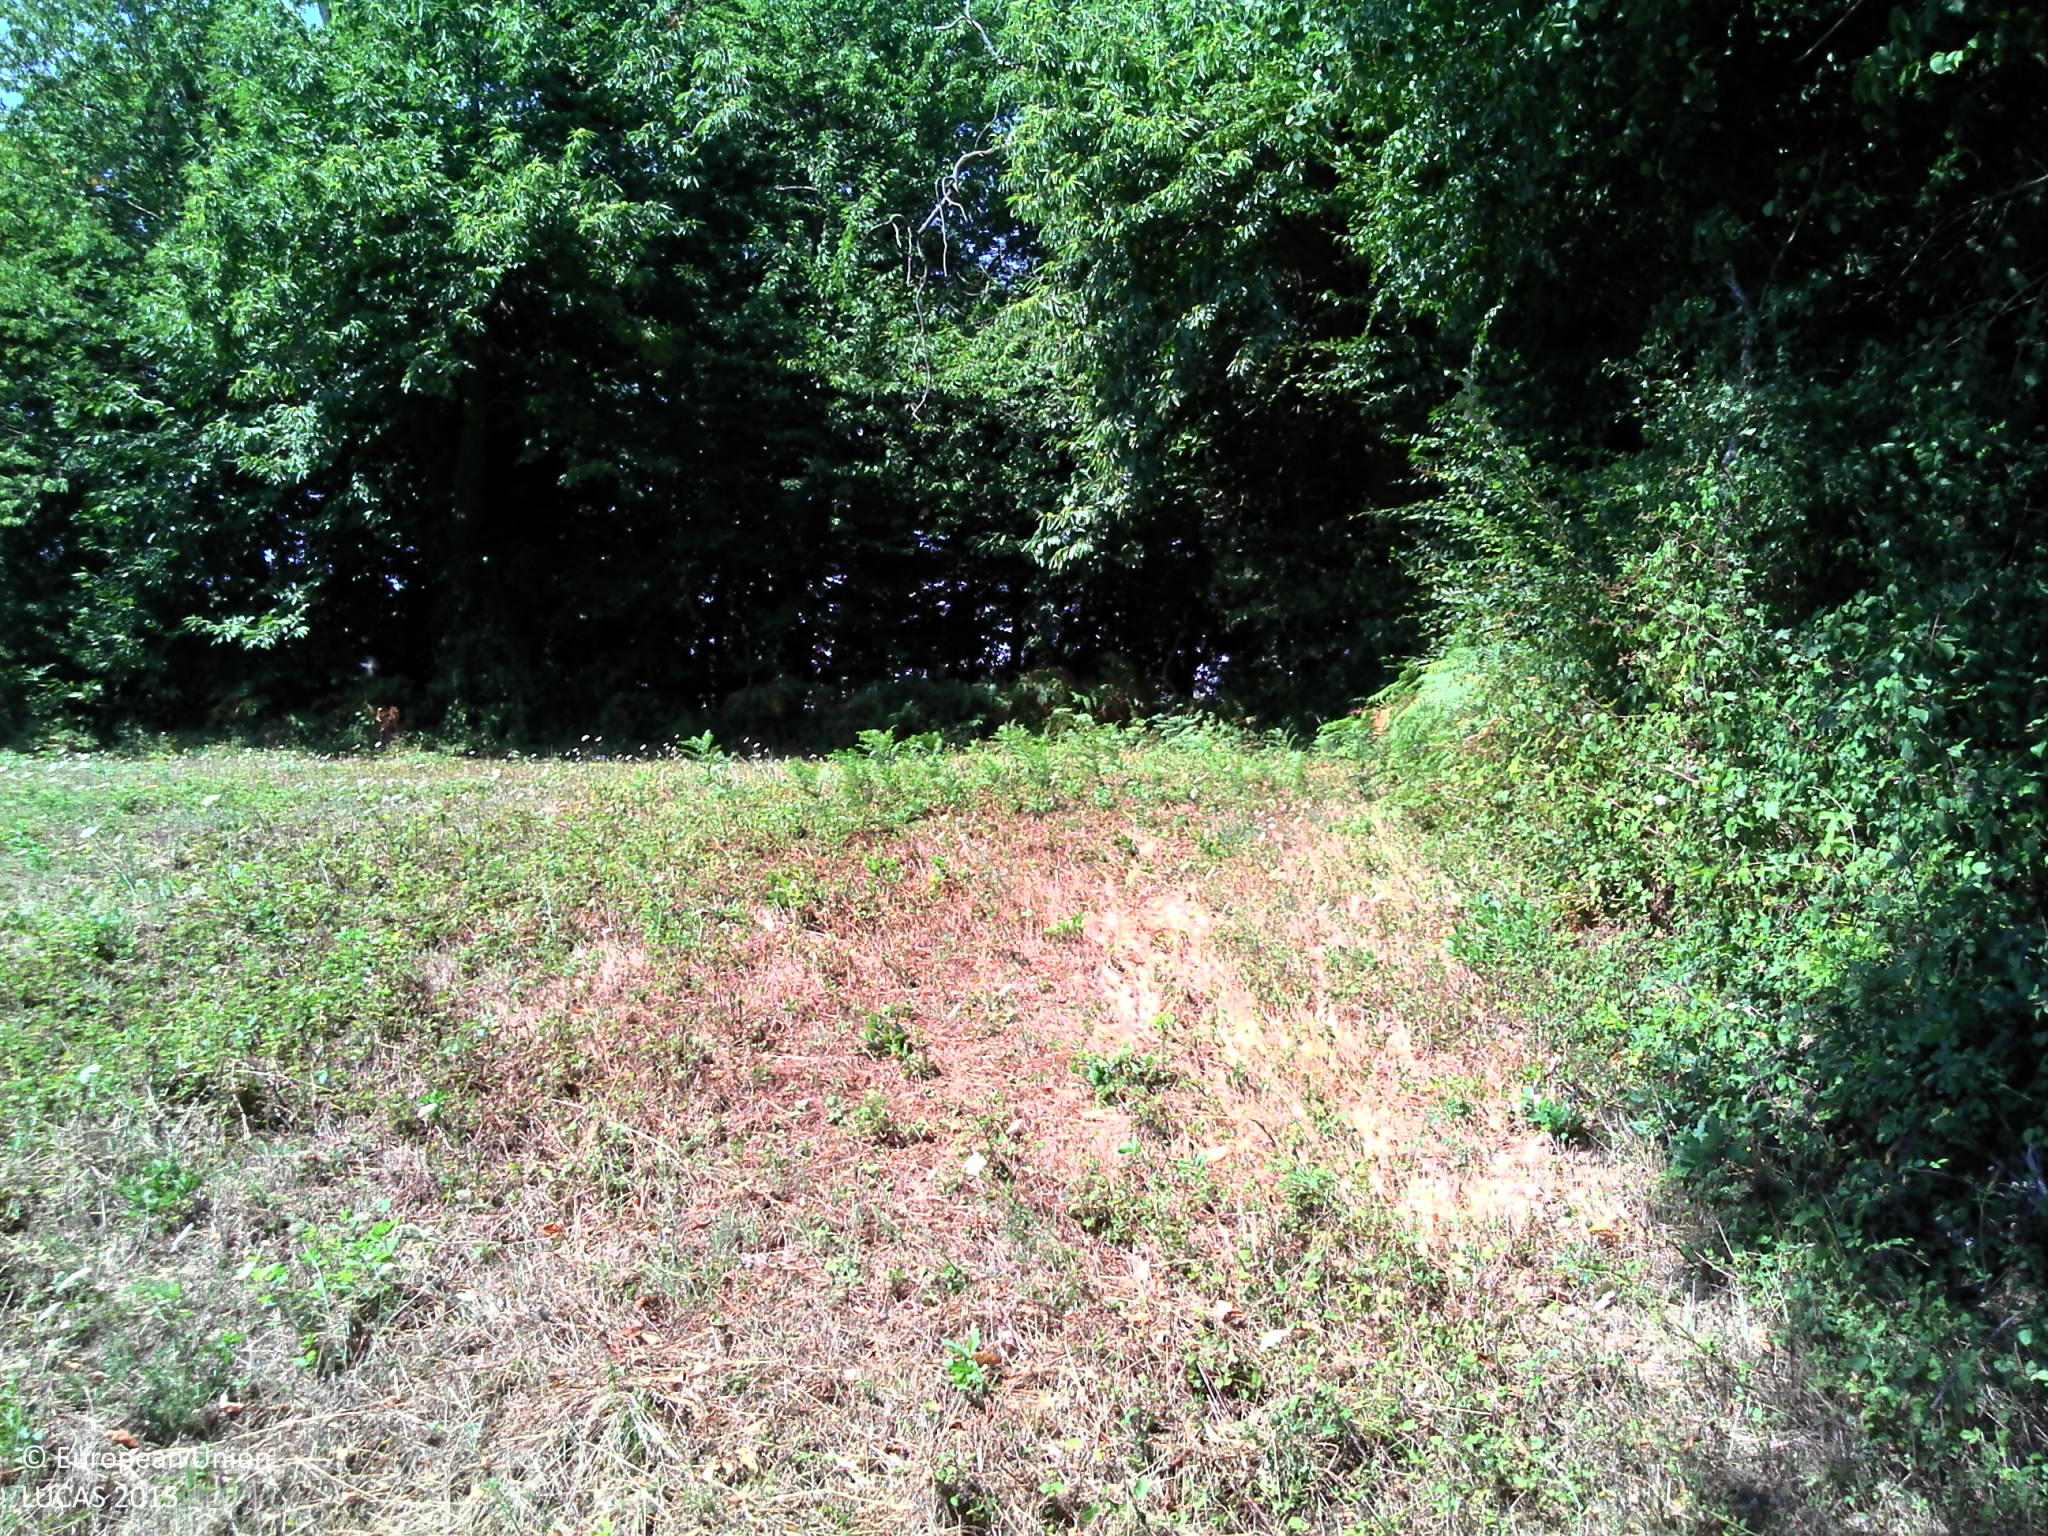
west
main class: Woodland
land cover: Broadleaved woodland
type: mesophytic deciduous forest
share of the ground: > 75 %
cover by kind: broadleaved forest trees 85 %, shrubs 10 %, herbaceous plants 5 %
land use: Forestry
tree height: > 5 m
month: August
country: FR
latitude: 46.2889
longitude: 0.2855
